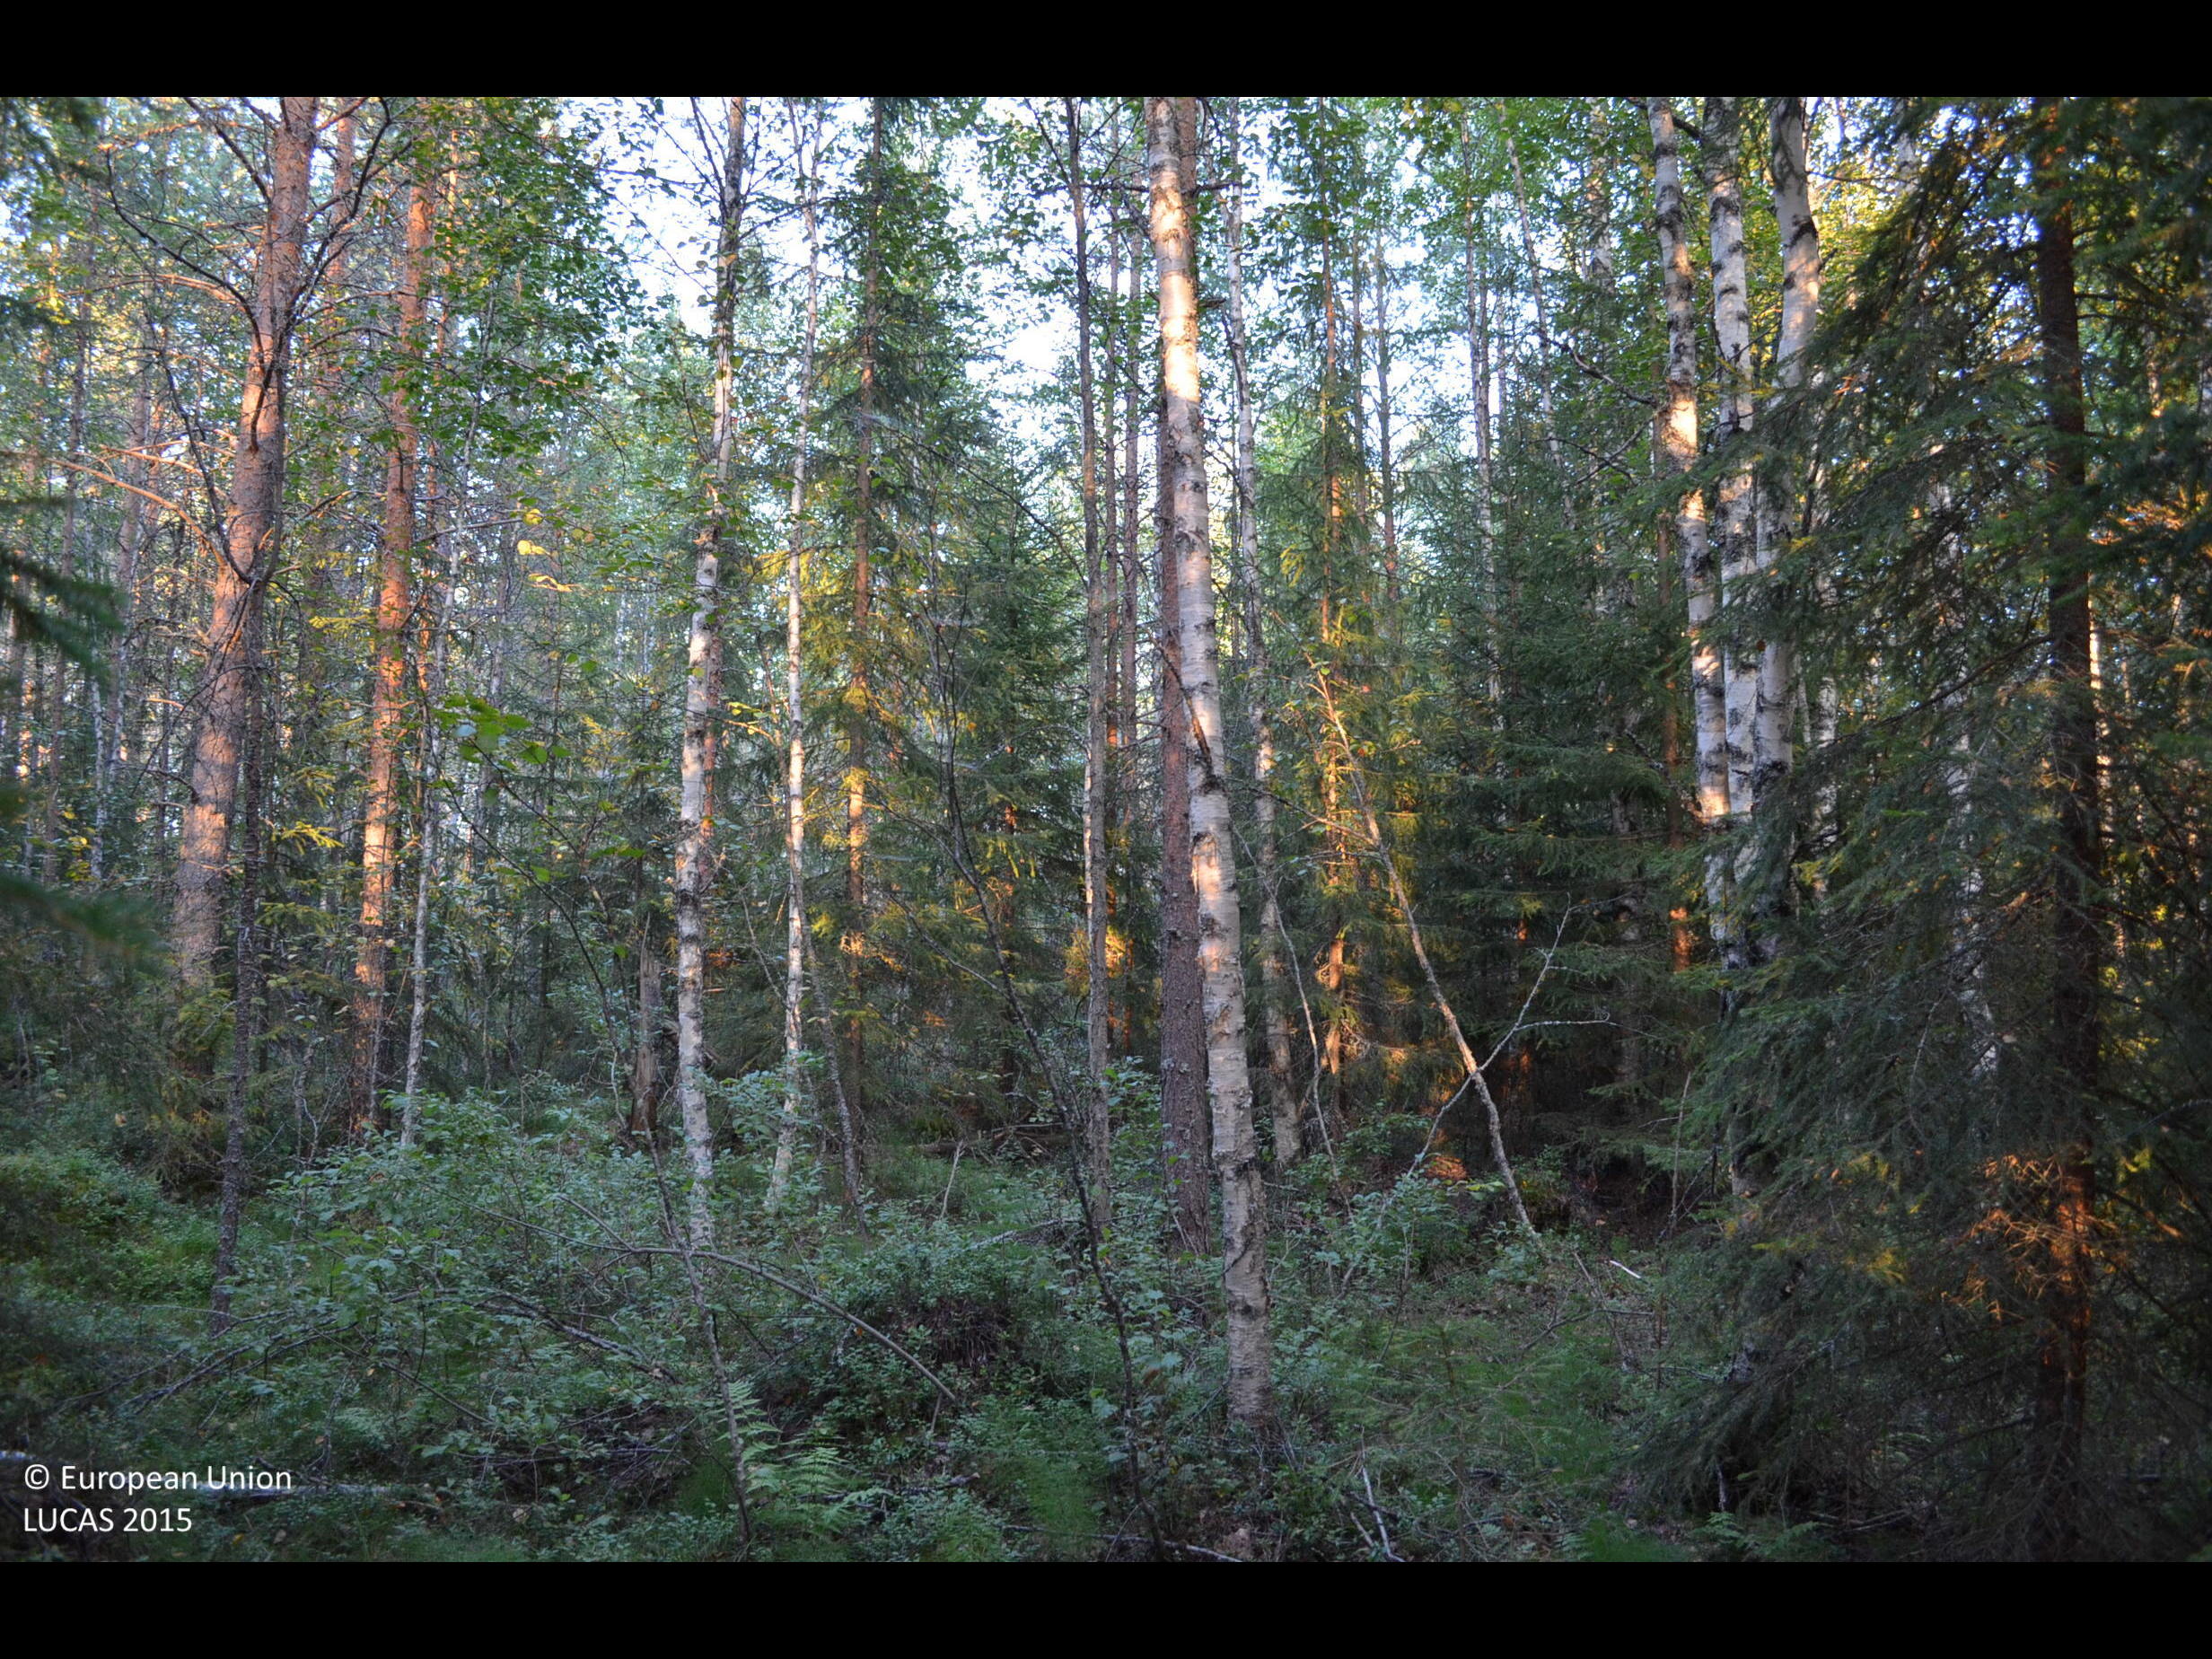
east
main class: Woodland
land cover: Other mixed woodland
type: boreal forest
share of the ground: > 75 %
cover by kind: coniferous forest trees 45 %, broadleaved forest trees 40 %, shrubs 5 %, herbaceous plants 5 %
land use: Forestry
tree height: > 5 m
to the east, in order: Other mixed woodland; Pine dominated mixed woodland; Pine dominated coniferous woodland; Ditches and canals; Shruby margins; Tracks; Shruby margins; Ditches and canals; Pine dominated coniferous woodland; Other mixed woodland; Ditches and canals; Other mixed woodland; Ditches and canals; Pine dominated coniferous woodland
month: August
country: FI
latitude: 62.4965
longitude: 24.4722
